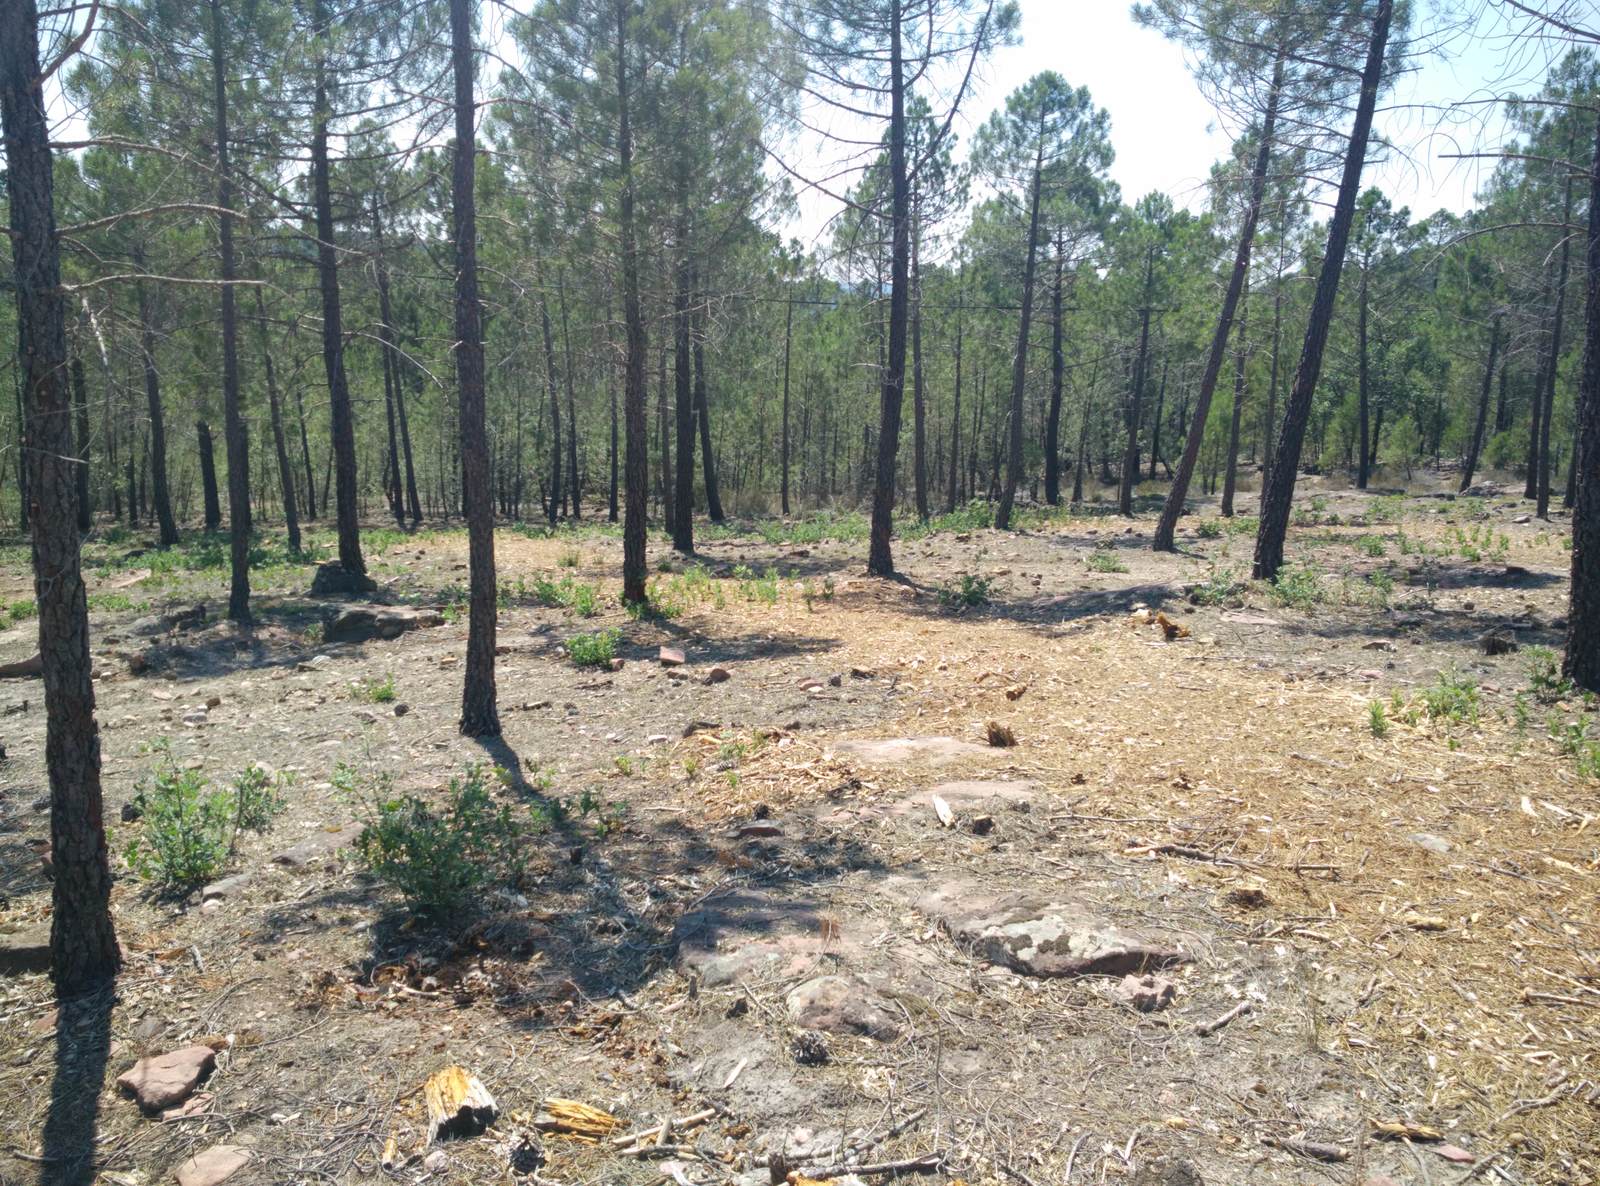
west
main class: Woodland
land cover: Pine dominated coniferous woodland
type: coniferous forest of the mediterranean region
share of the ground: 25 - 50 %
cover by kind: unconsolidated bare surface 50 %, coniferous forest trees 40 %, shrubs 10 %
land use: Semi-natural and natural areas not in use
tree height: > 5 m
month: July
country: ES
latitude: 40.8684
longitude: -2.0910
